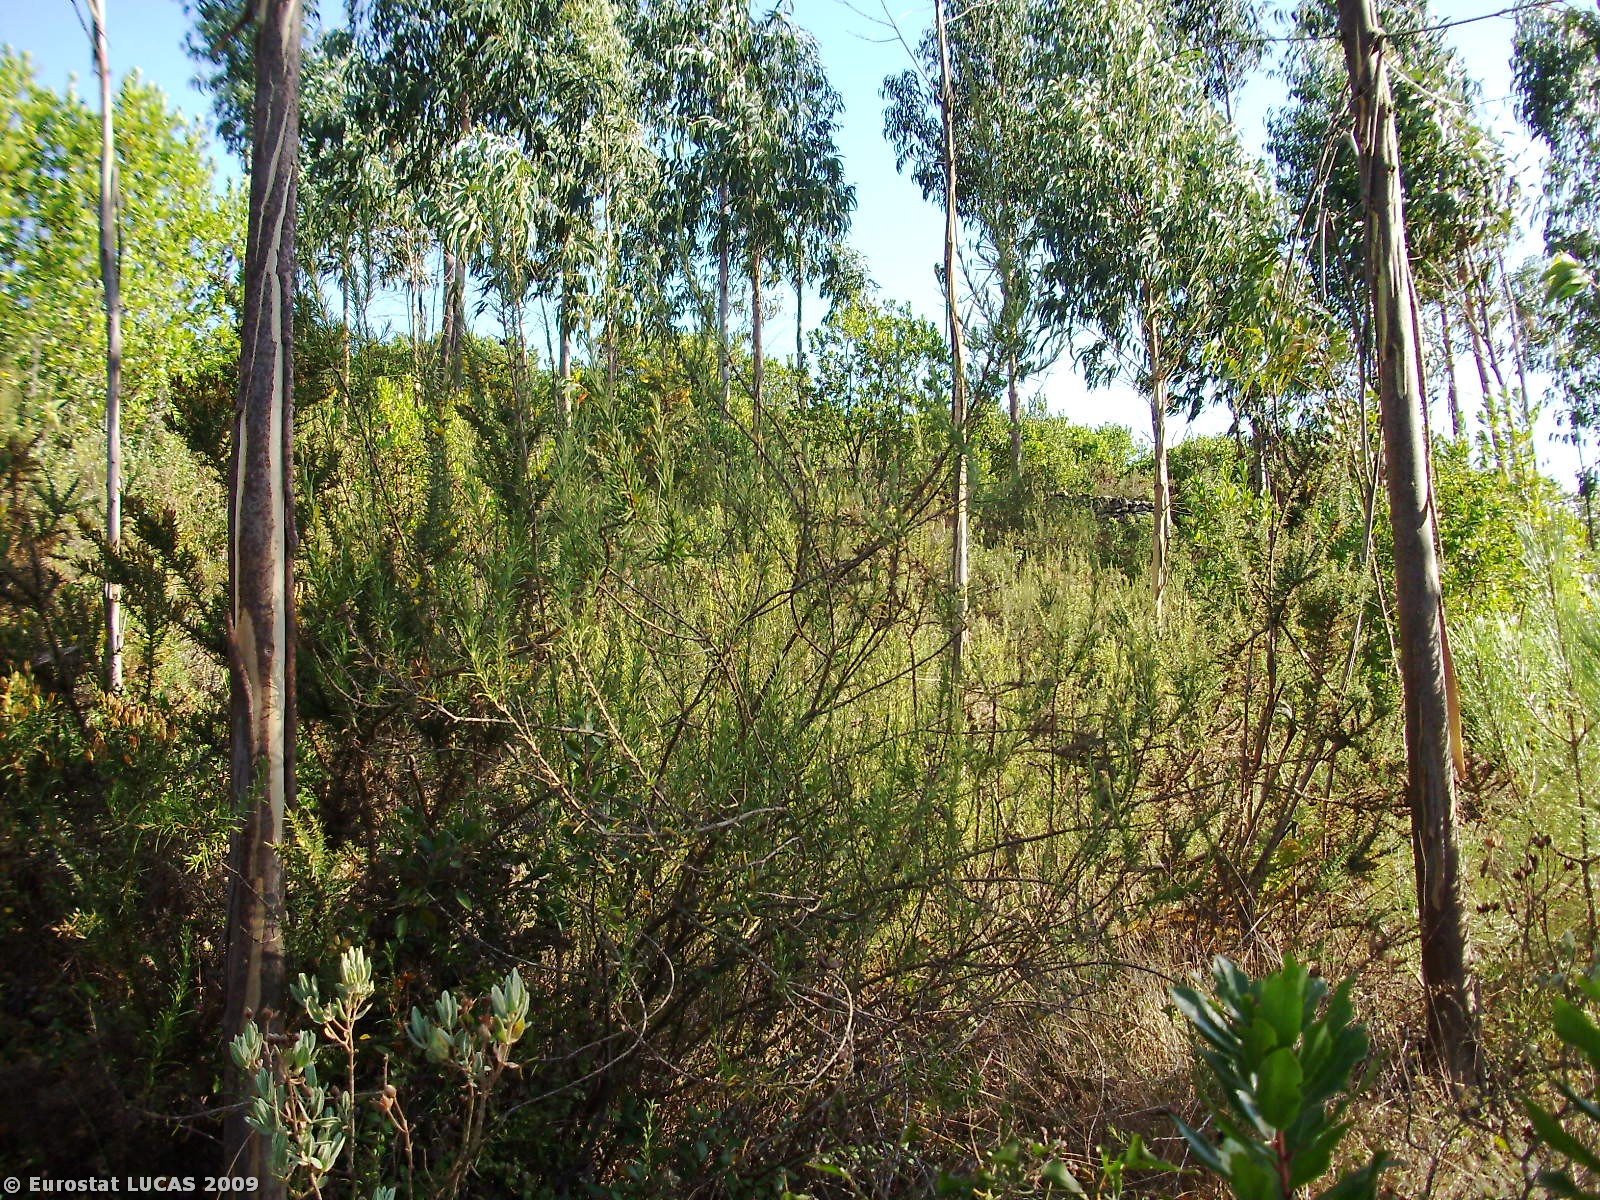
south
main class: Woodland
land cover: Broadleaved woodland
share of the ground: 25 - 50 %
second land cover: Shrubland with sparse tree cover
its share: 50 - 75 %
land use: Forestry
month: August
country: PT
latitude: 40.0409
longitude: -8.4226
